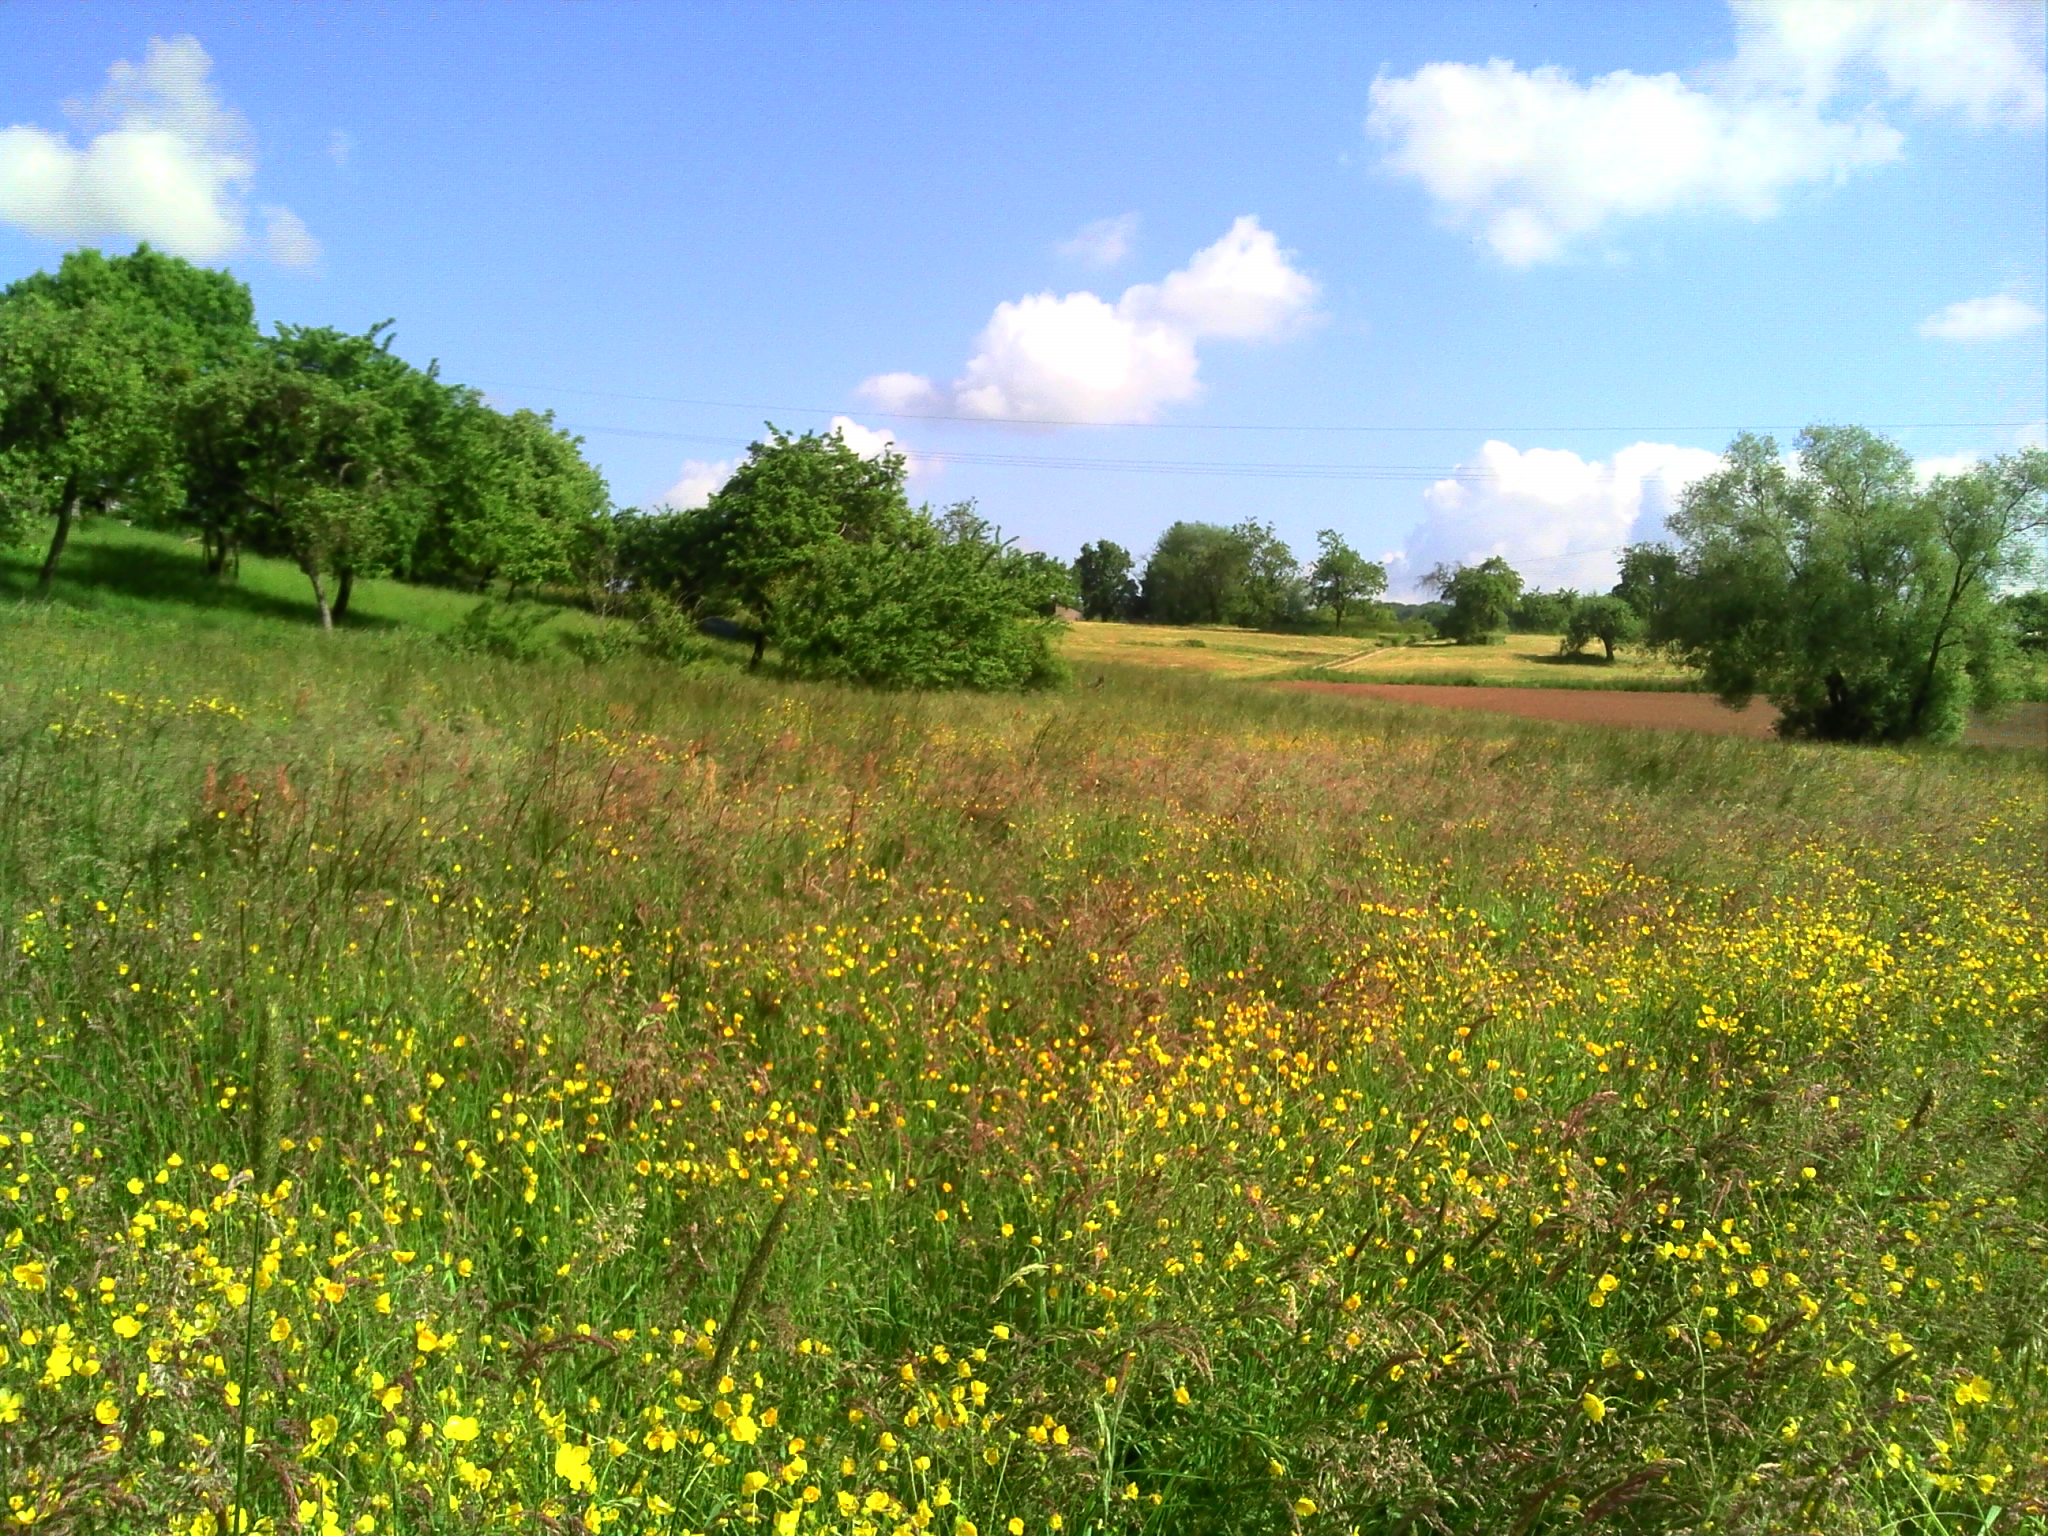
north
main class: Grassland
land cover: Grassland without tree/shrub cover
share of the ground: > 75 %
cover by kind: herbaceous plants 100 %
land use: Agriculture (excluding fallow land and kitchen gardens)
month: May
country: LU
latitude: 49.5655
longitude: 6.2803
